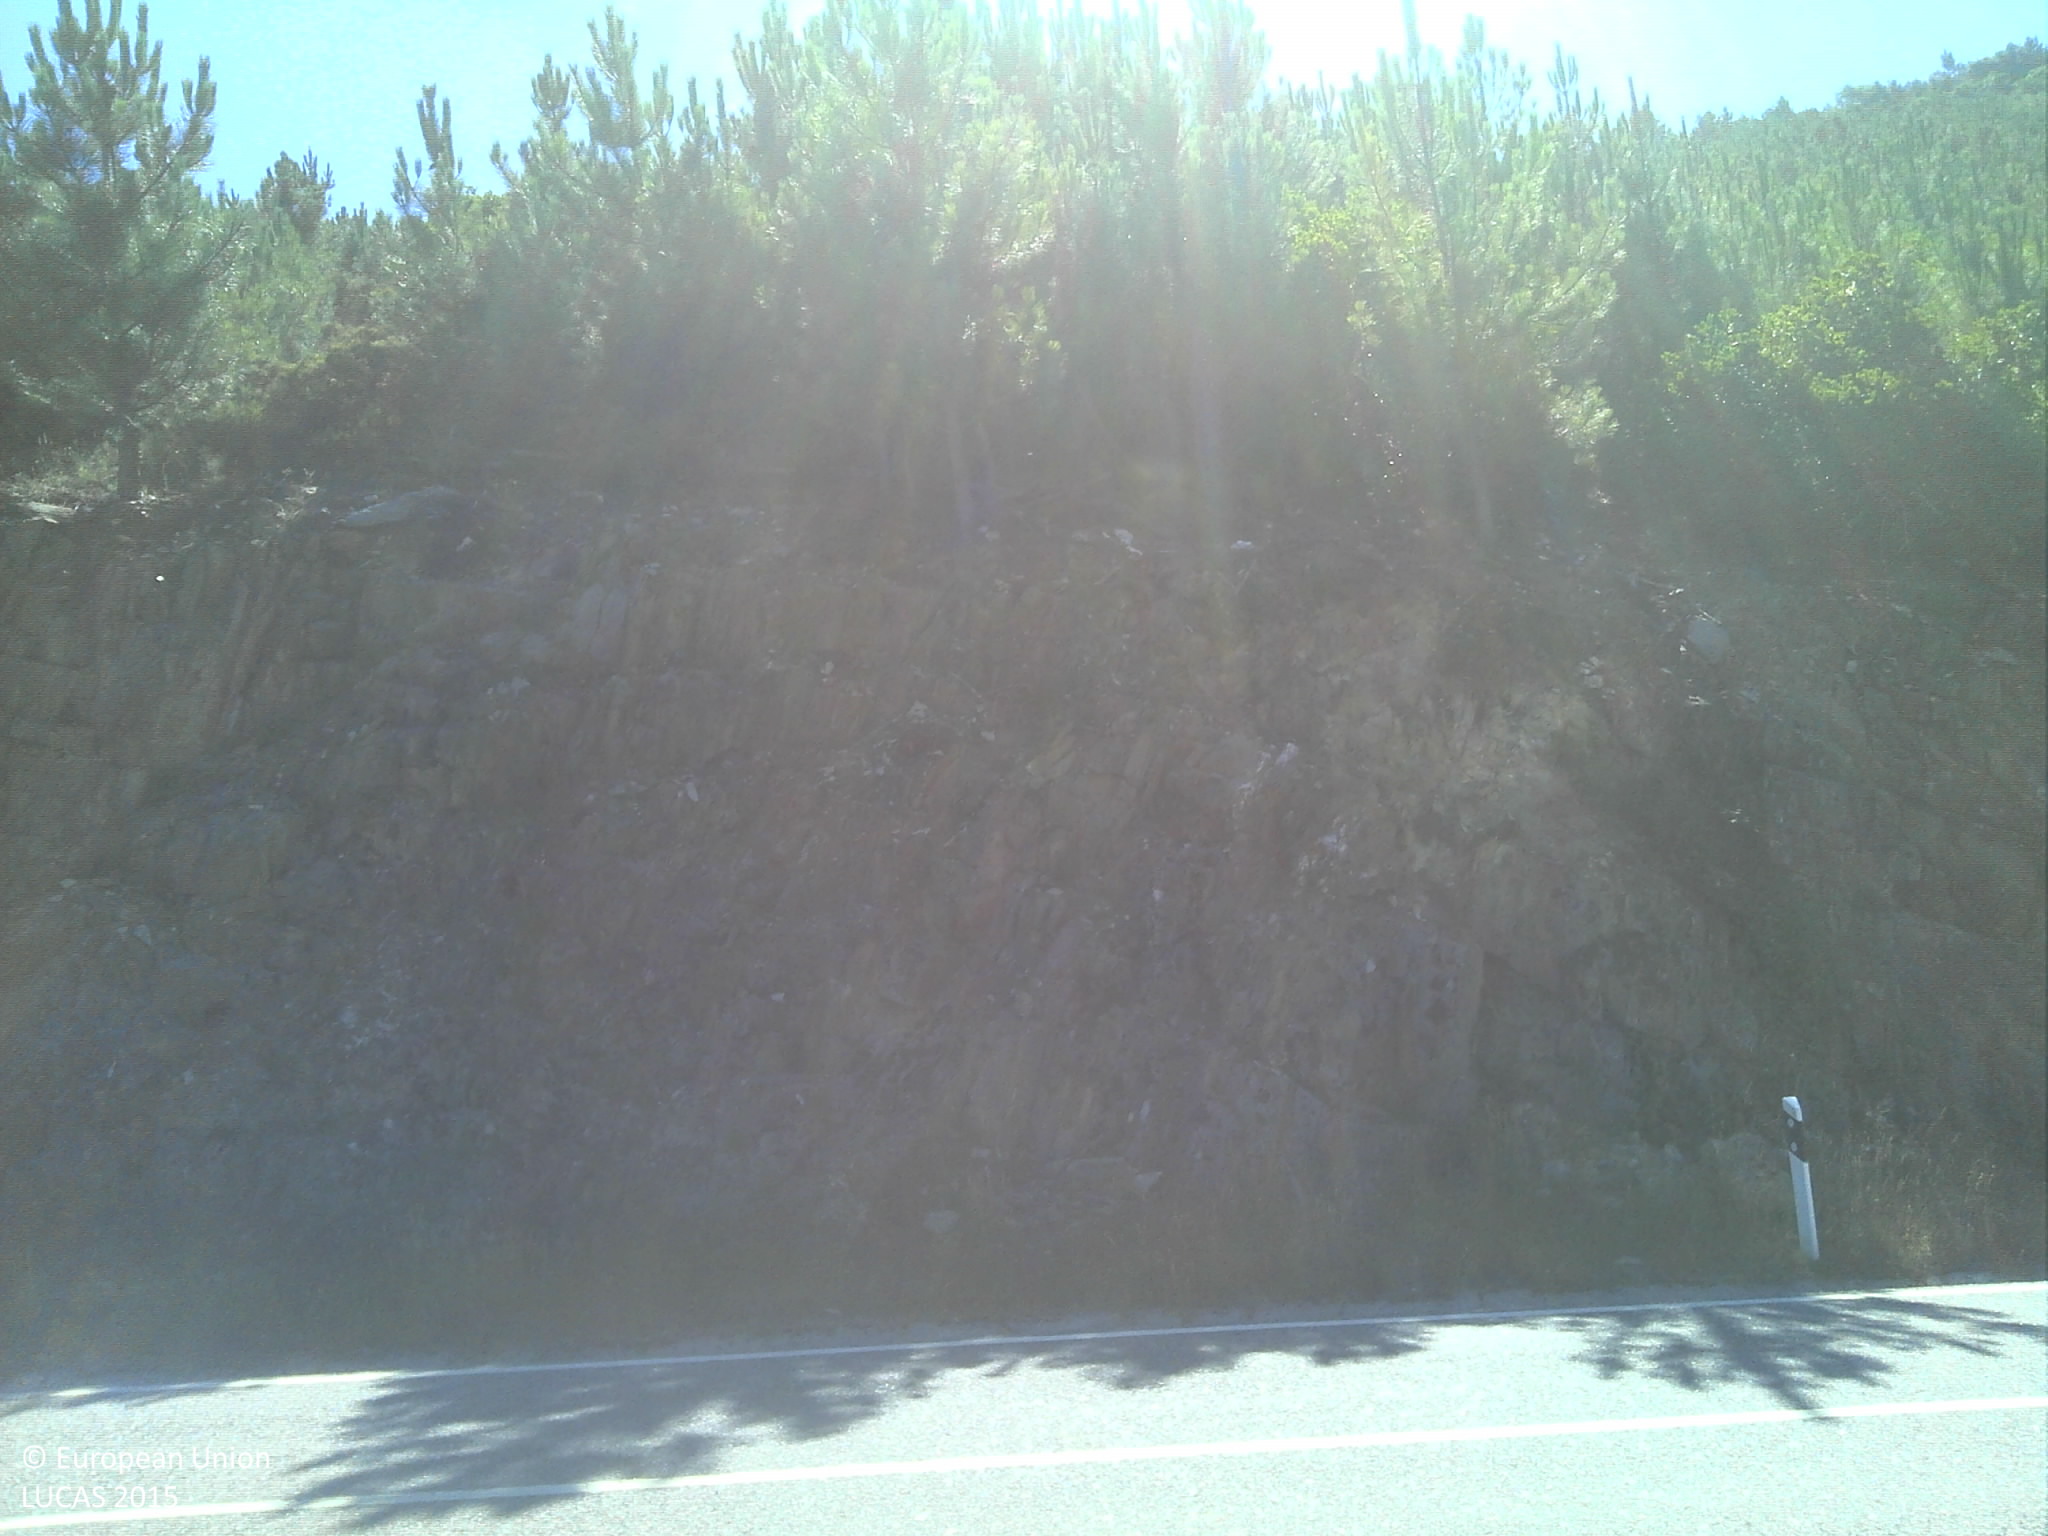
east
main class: Shrubland
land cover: Shrubland with sparse tree cover
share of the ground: 25 - 50 %
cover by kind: shrubs 40 %, herbaceous plants 30 %, unconsolidated bare surface 25 %, broadleaved forest trees 5 %
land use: Semi-natural and natural areas not in use
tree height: > 5 m
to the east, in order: Shrubland with sparse tree cover; Grass margins; Paved roads, cycling and walking lanes; Grass margins; Pine dominated coniferous woodland; Shrubland without tree cover; Grass margins; Paved roads, cycling and walking lanes; Grass margins; Shrubland without tree cover
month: July
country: PT
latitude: 40.2439
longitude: -7.7335
